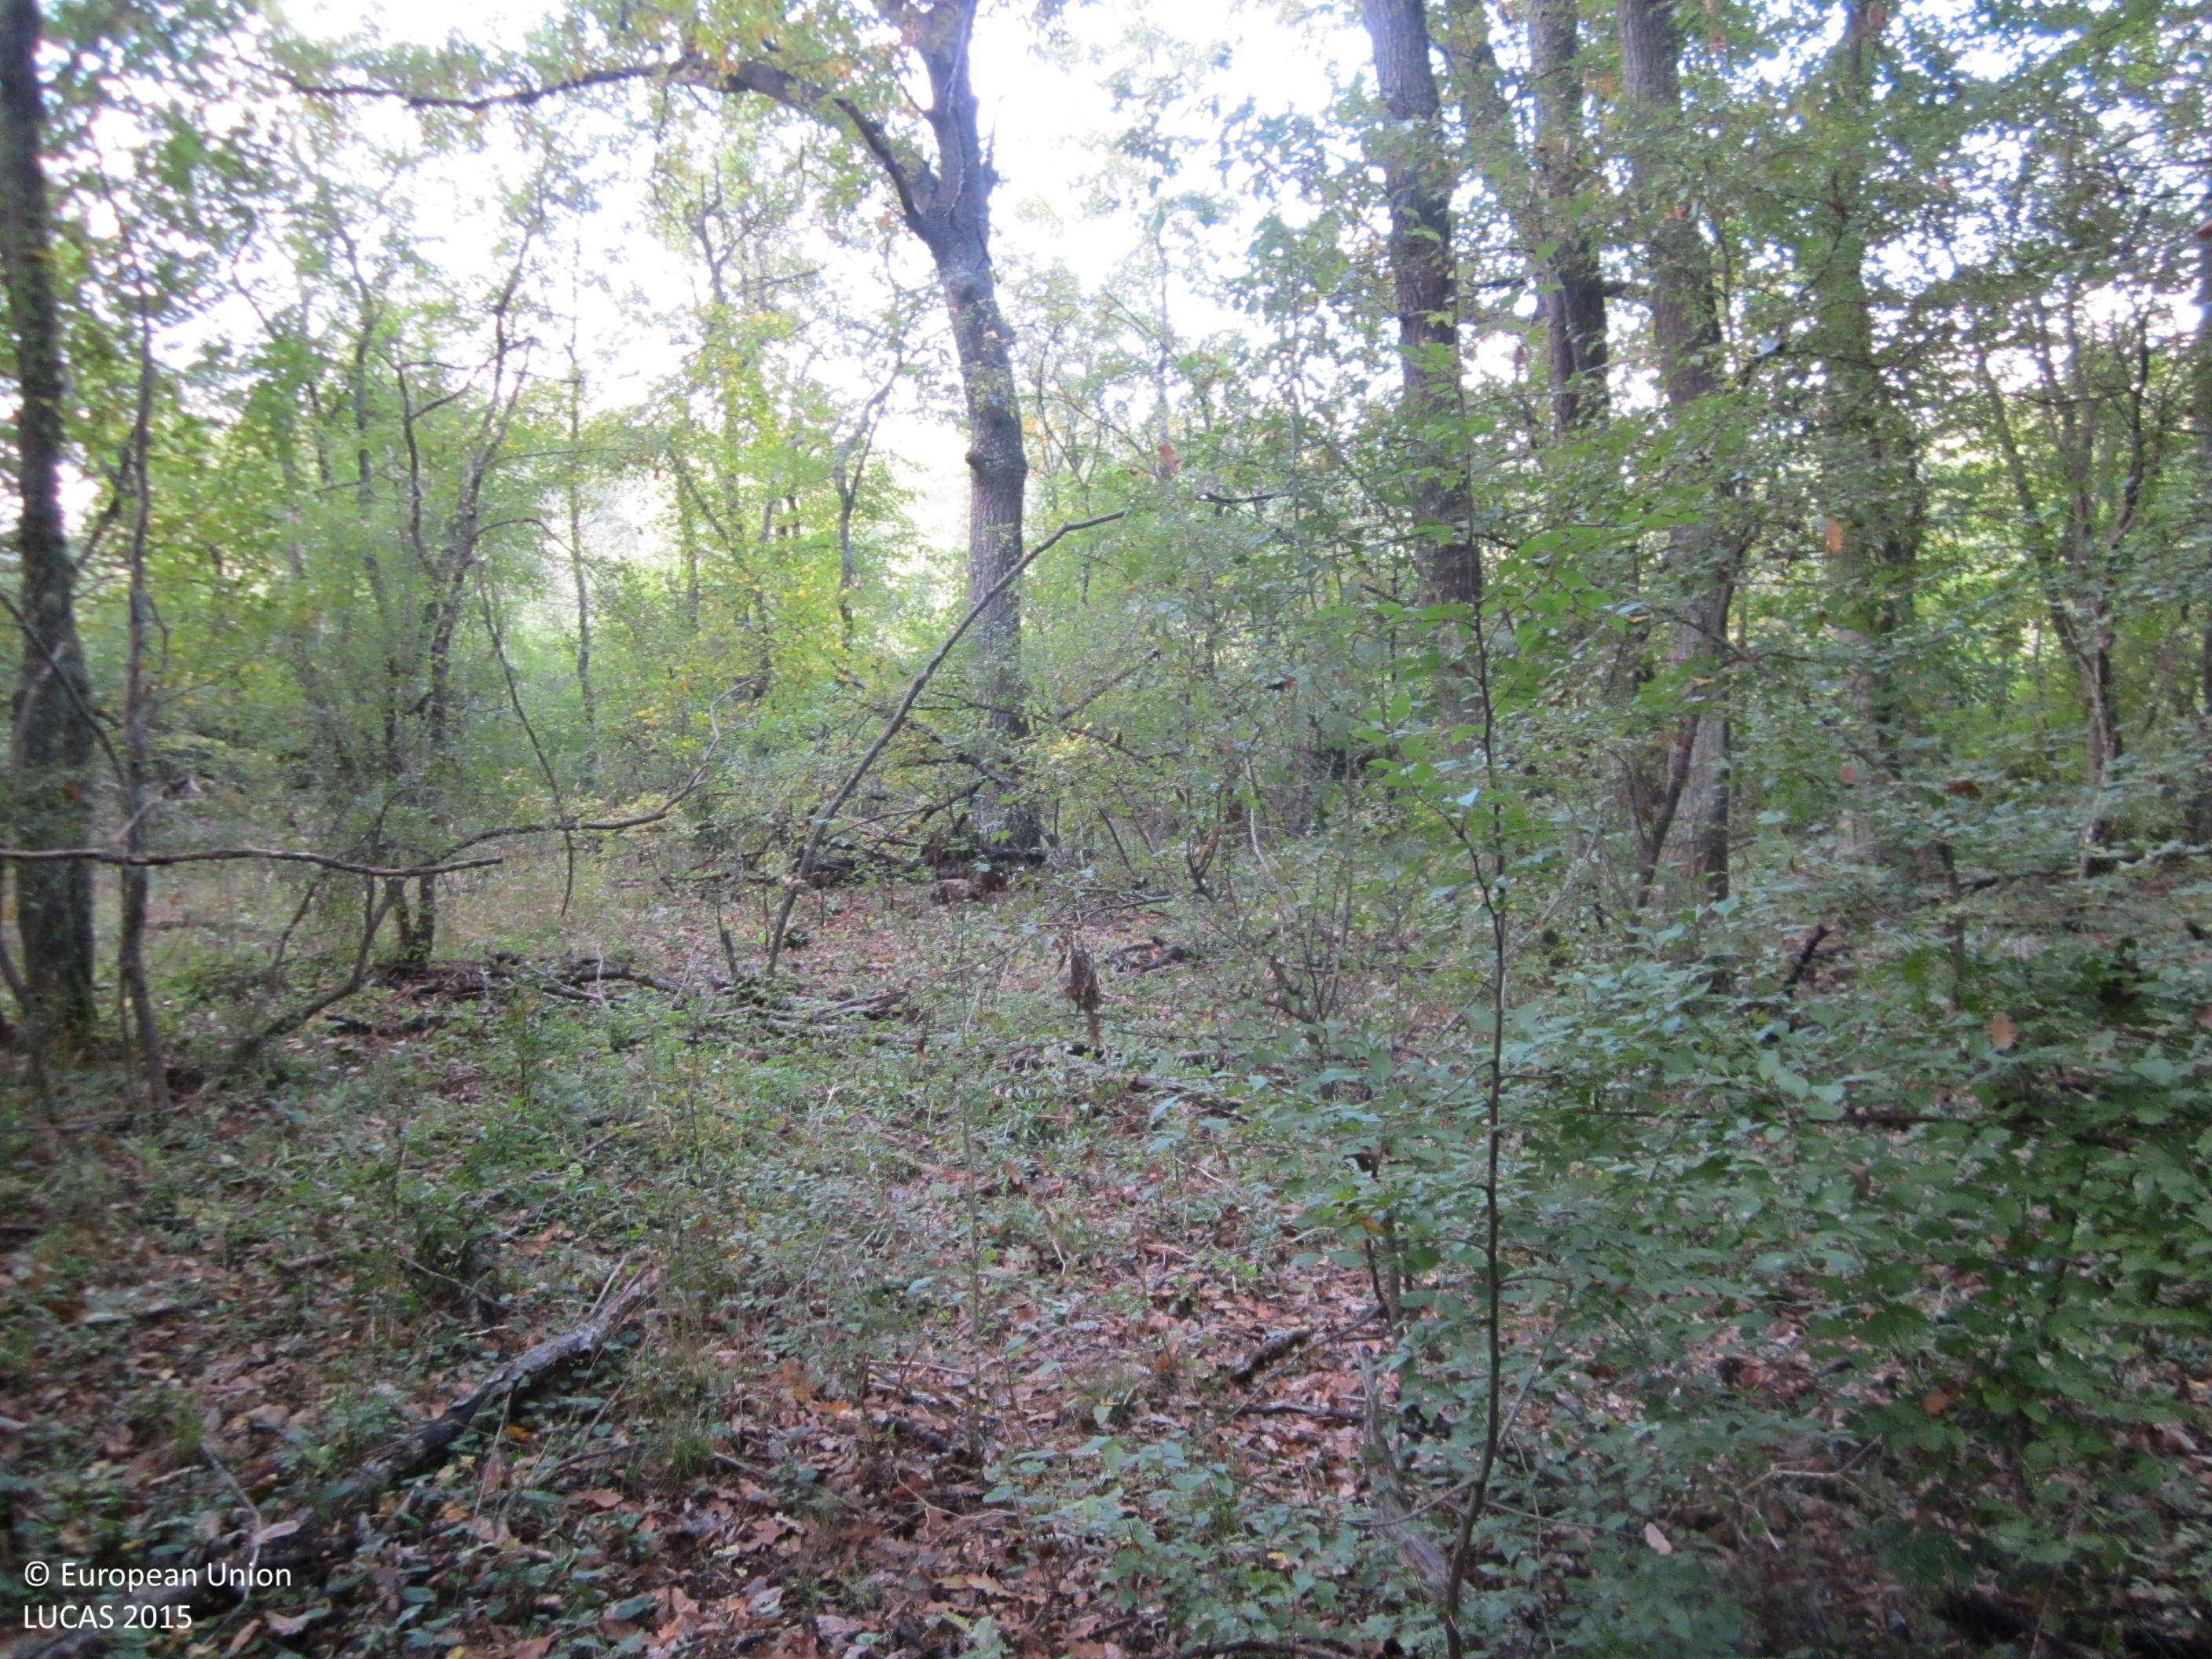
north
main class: Woodland
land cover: Broadleaved woodland
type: mesophytic deciduous forest
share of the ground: > 75 %
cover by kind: broadleaved forest trees 90 %, herbaceous plants 5 %, unconsolidated bare surface 5 %
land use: Forestry
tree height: > 5 m
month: October
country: BG
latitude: 42.1899
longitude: 27.2655
